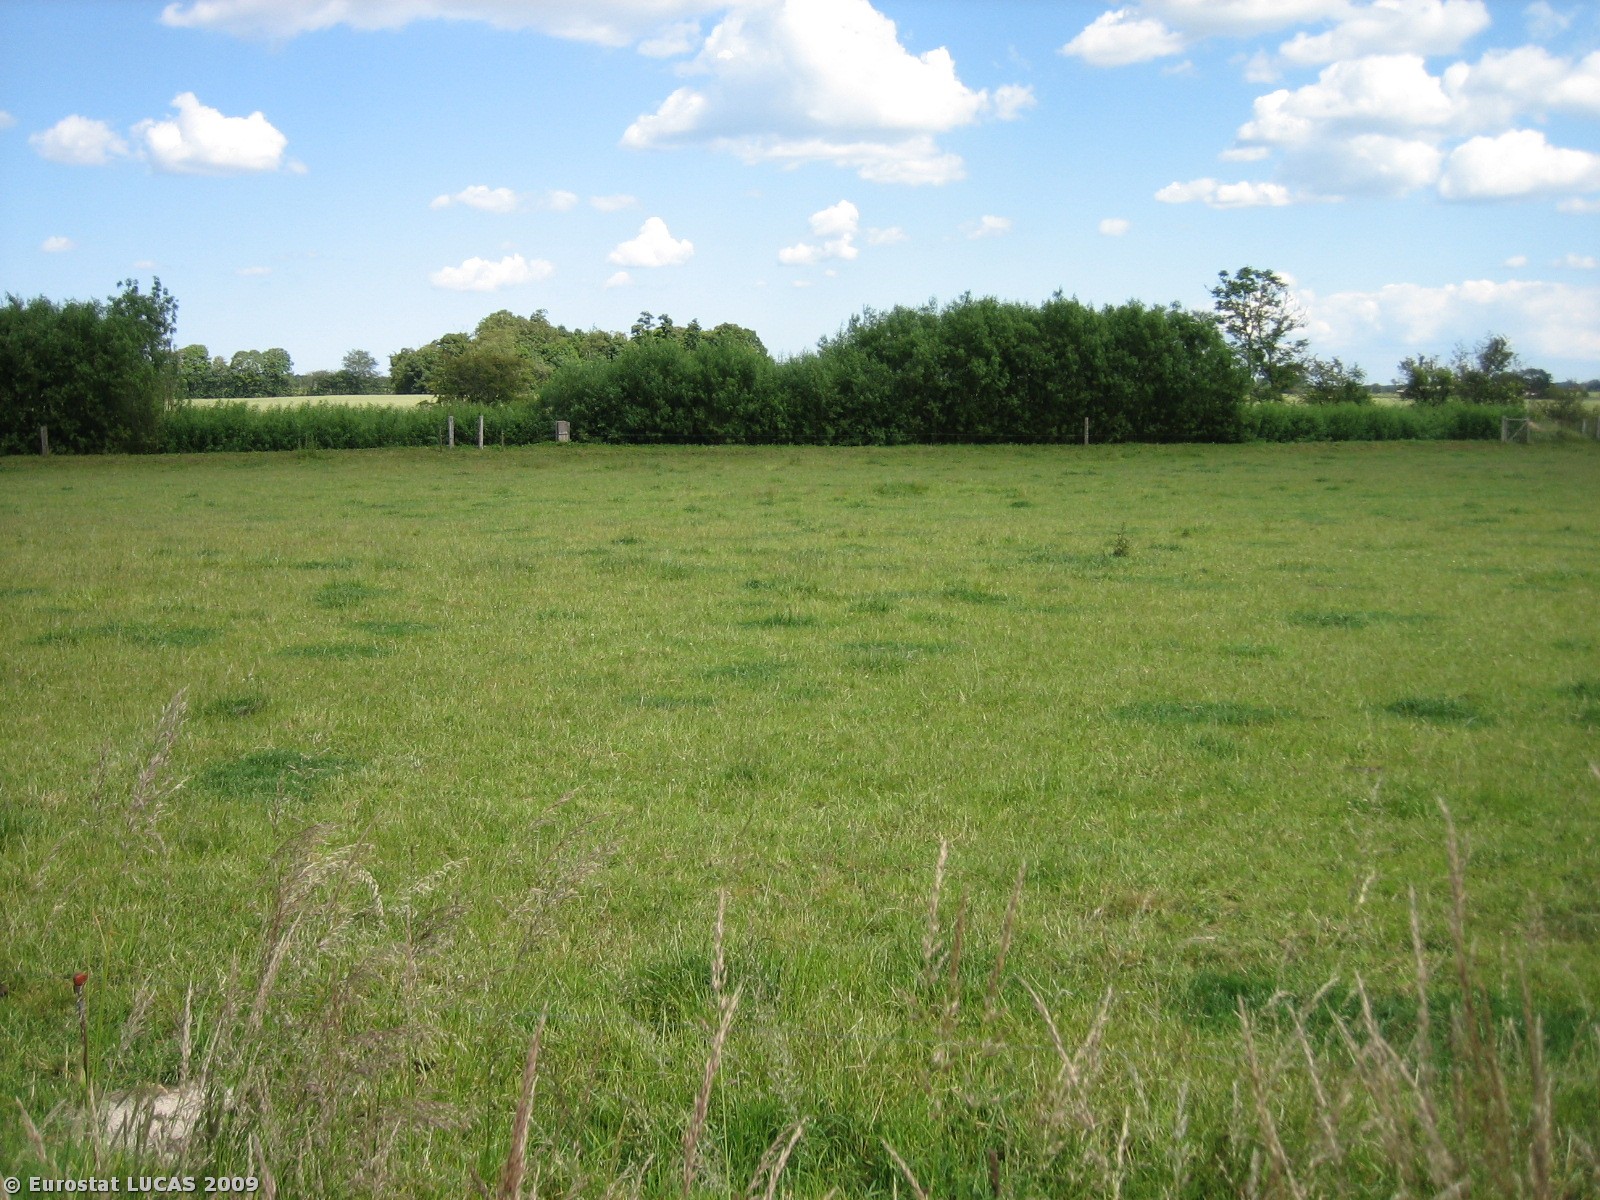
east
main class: Woodland
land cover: Broadleaved woodland
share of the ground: > 75 %
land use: Forestry
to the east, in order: Broadleaved woodland; Fences; Grassland without tree/shrub cover; Fences; Broadleaved woodland; Ditches and canals; Grass margins; Common wheat
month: June
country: DK
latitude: 55.5381
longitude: 9.1926
